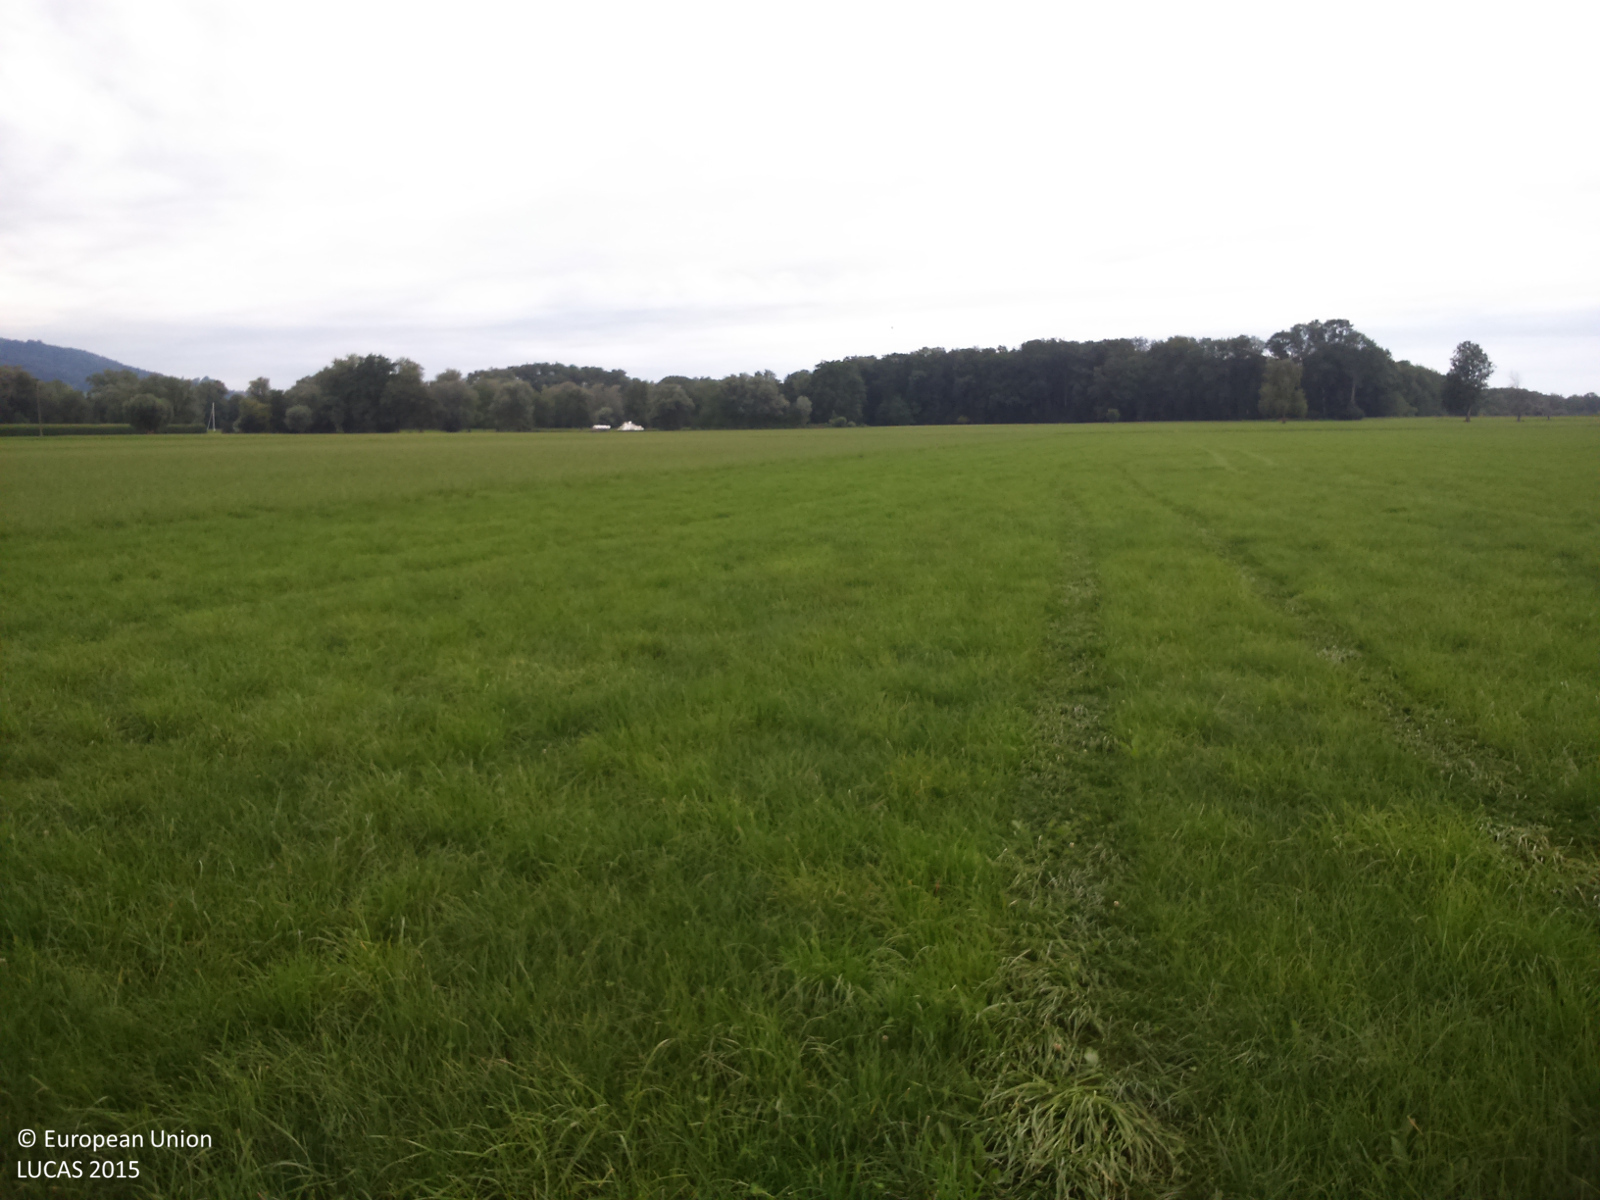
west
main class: Grassland
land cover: Grassland without tree/shrub cover
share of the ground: > 75 %
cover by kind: herbaceous plants 100 %
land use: Agriculture (excluding fallow land and kitchen gardens)
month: August
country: AT
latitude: 47.4848
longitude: 9.5890
